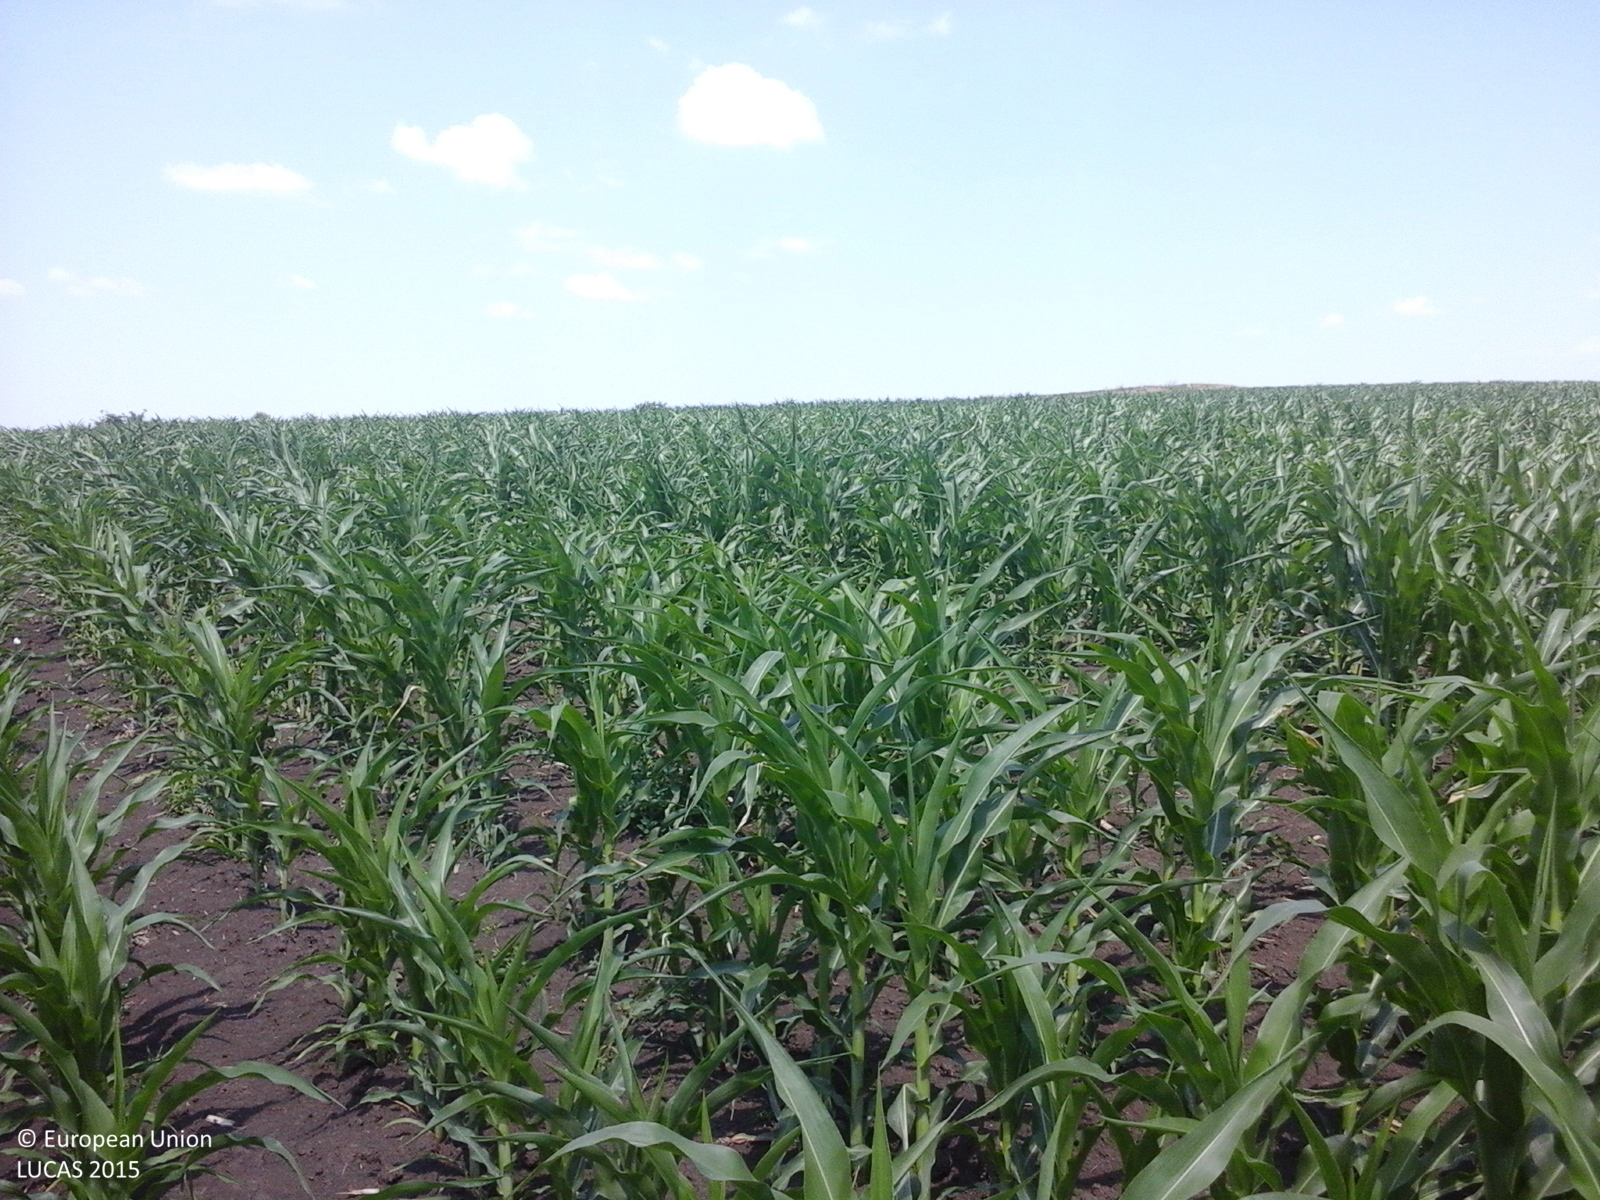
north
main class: Cropland
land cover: Maize
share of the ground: > 75 %
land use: Agriculture (excluding fallow land and kitchen gardens)
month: June
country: RO
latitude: 47.2069
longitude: 27.2038
